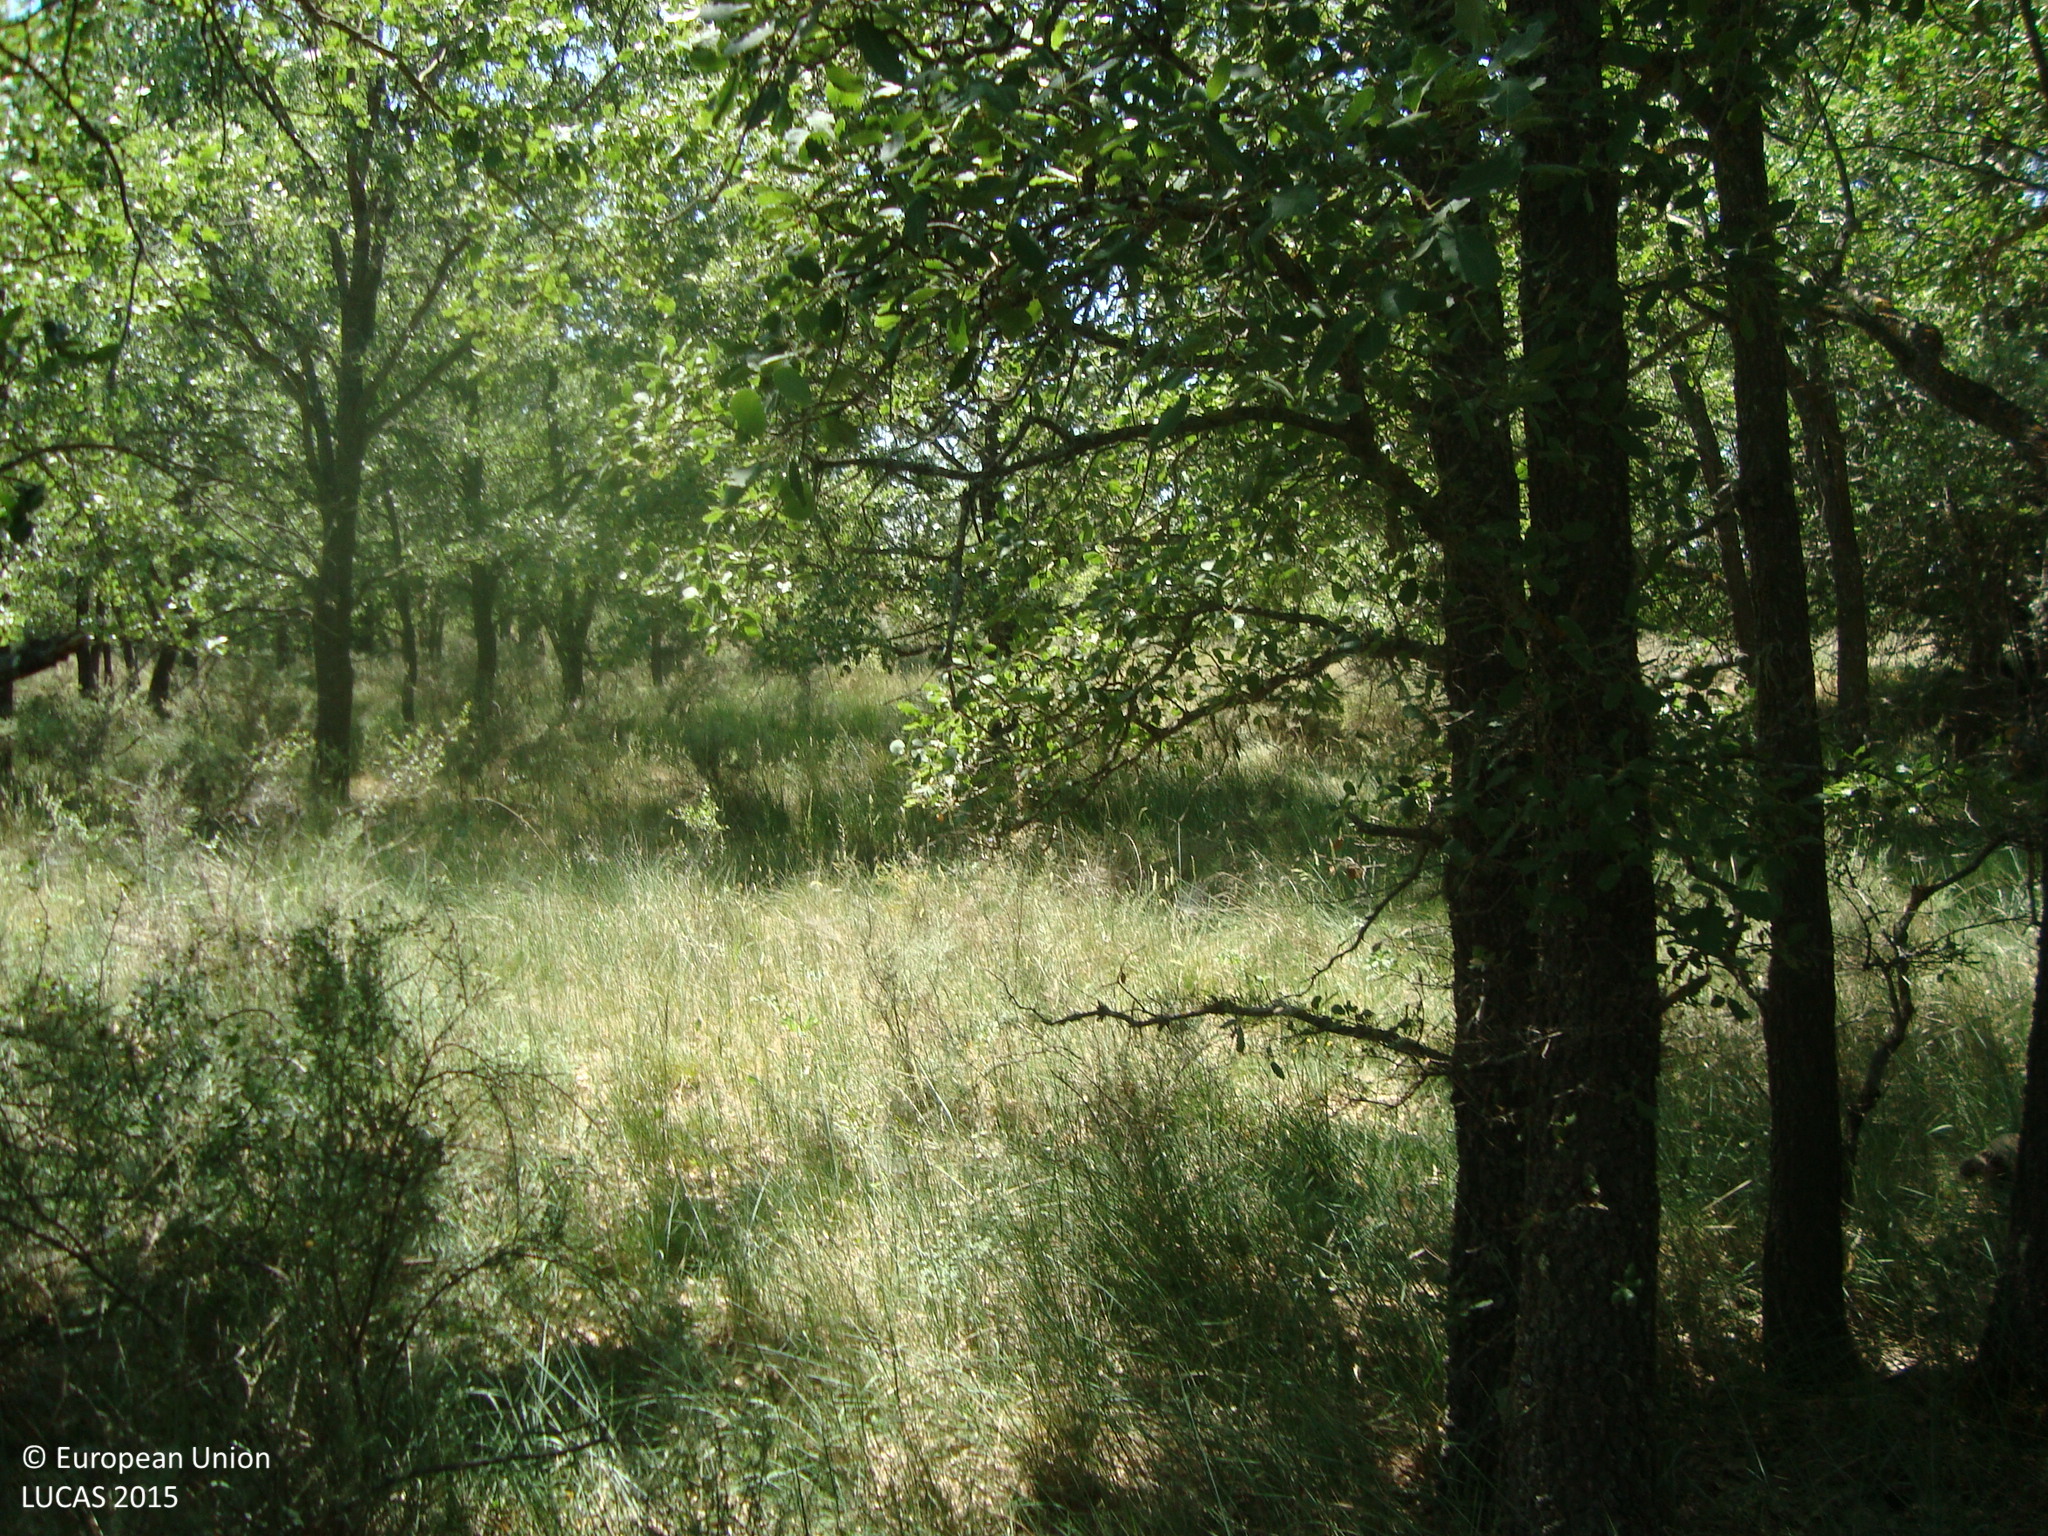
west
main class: Woodland
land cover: Broadleaved woodland
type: thermophilous deciduous forest
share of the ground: 50 - 75 %
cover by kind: broadleaved forest trees 60 %, herbaceous plants 20 %, shrubs 10 %, unconsolidated bare surface 10 %
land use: Forestry
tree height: > 5 m
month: June
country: ES
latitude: 41.8302
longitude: -3.5504
